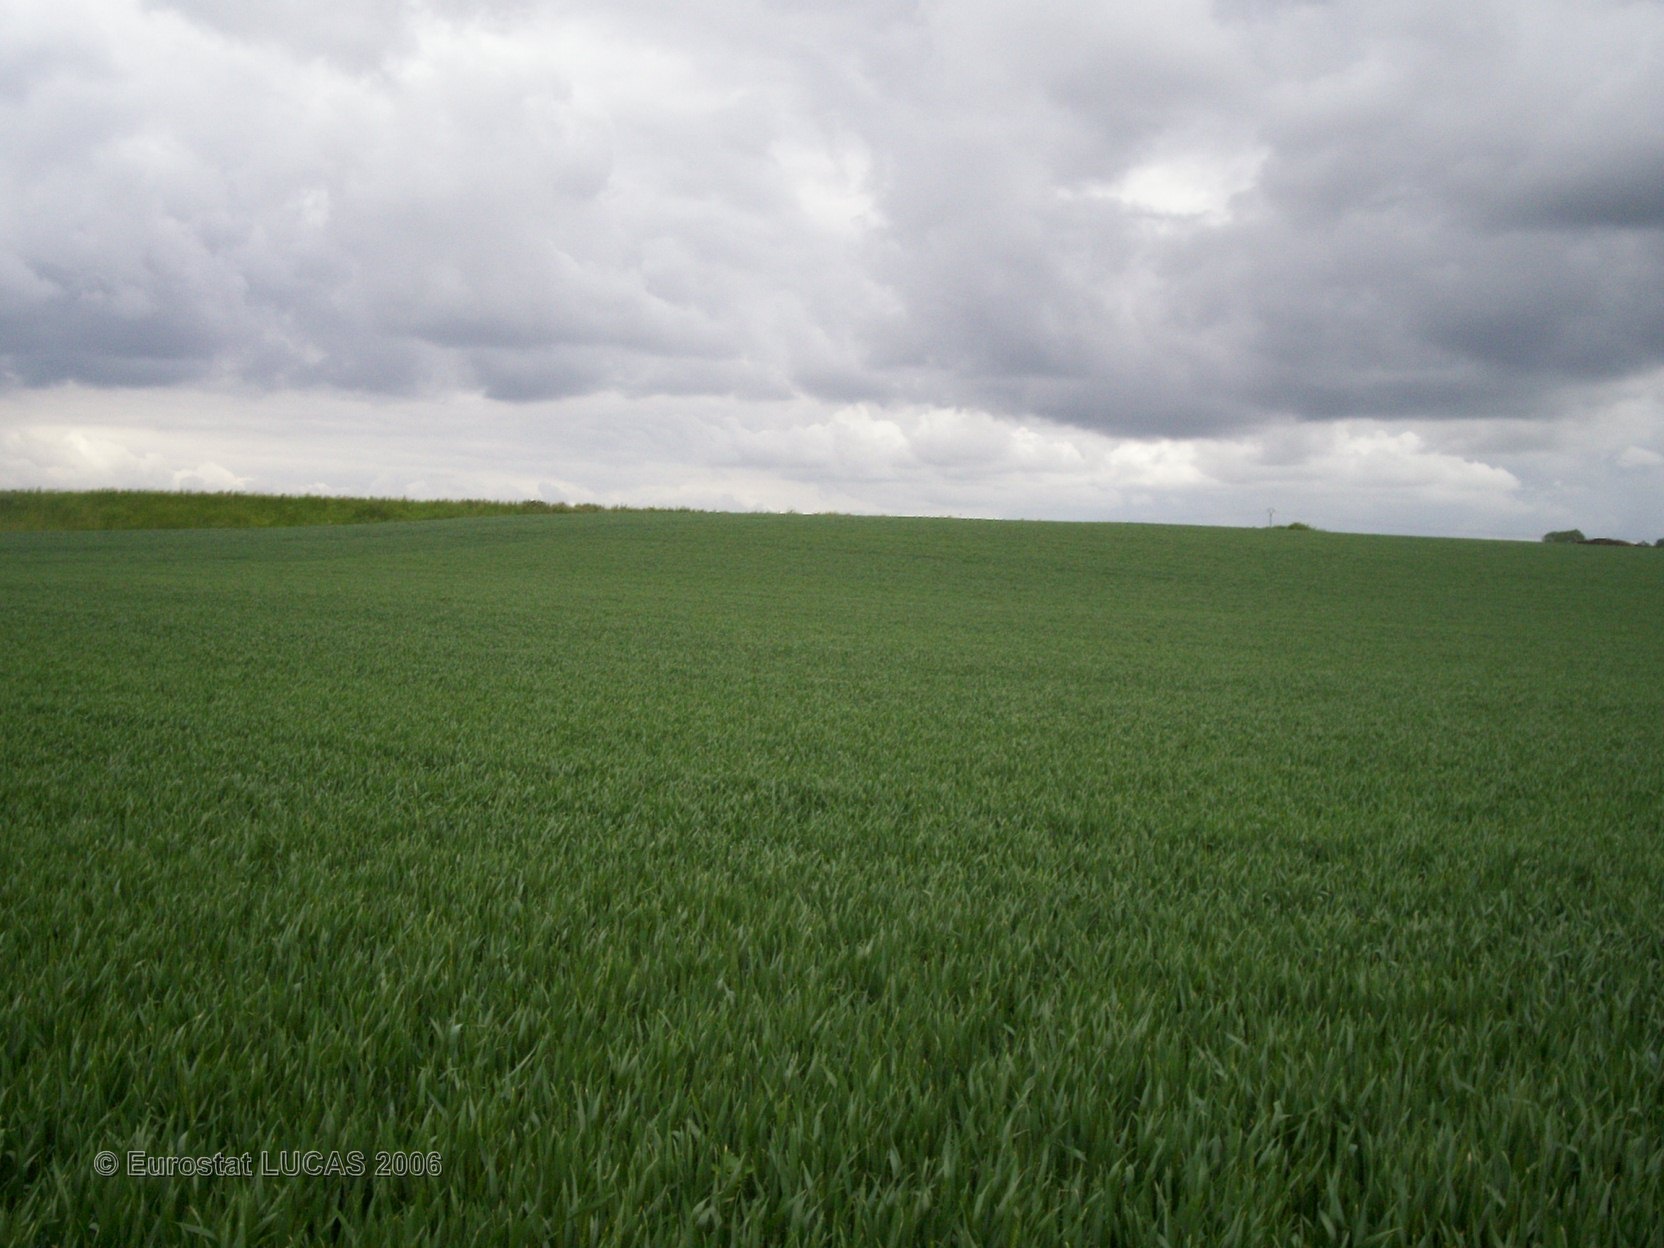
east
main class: Cropland
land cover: Common wheat
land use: Agriculture (excluding fallow land and kitchen gardens)
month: May
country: FR
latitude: 49.7820
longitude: 2.6137
